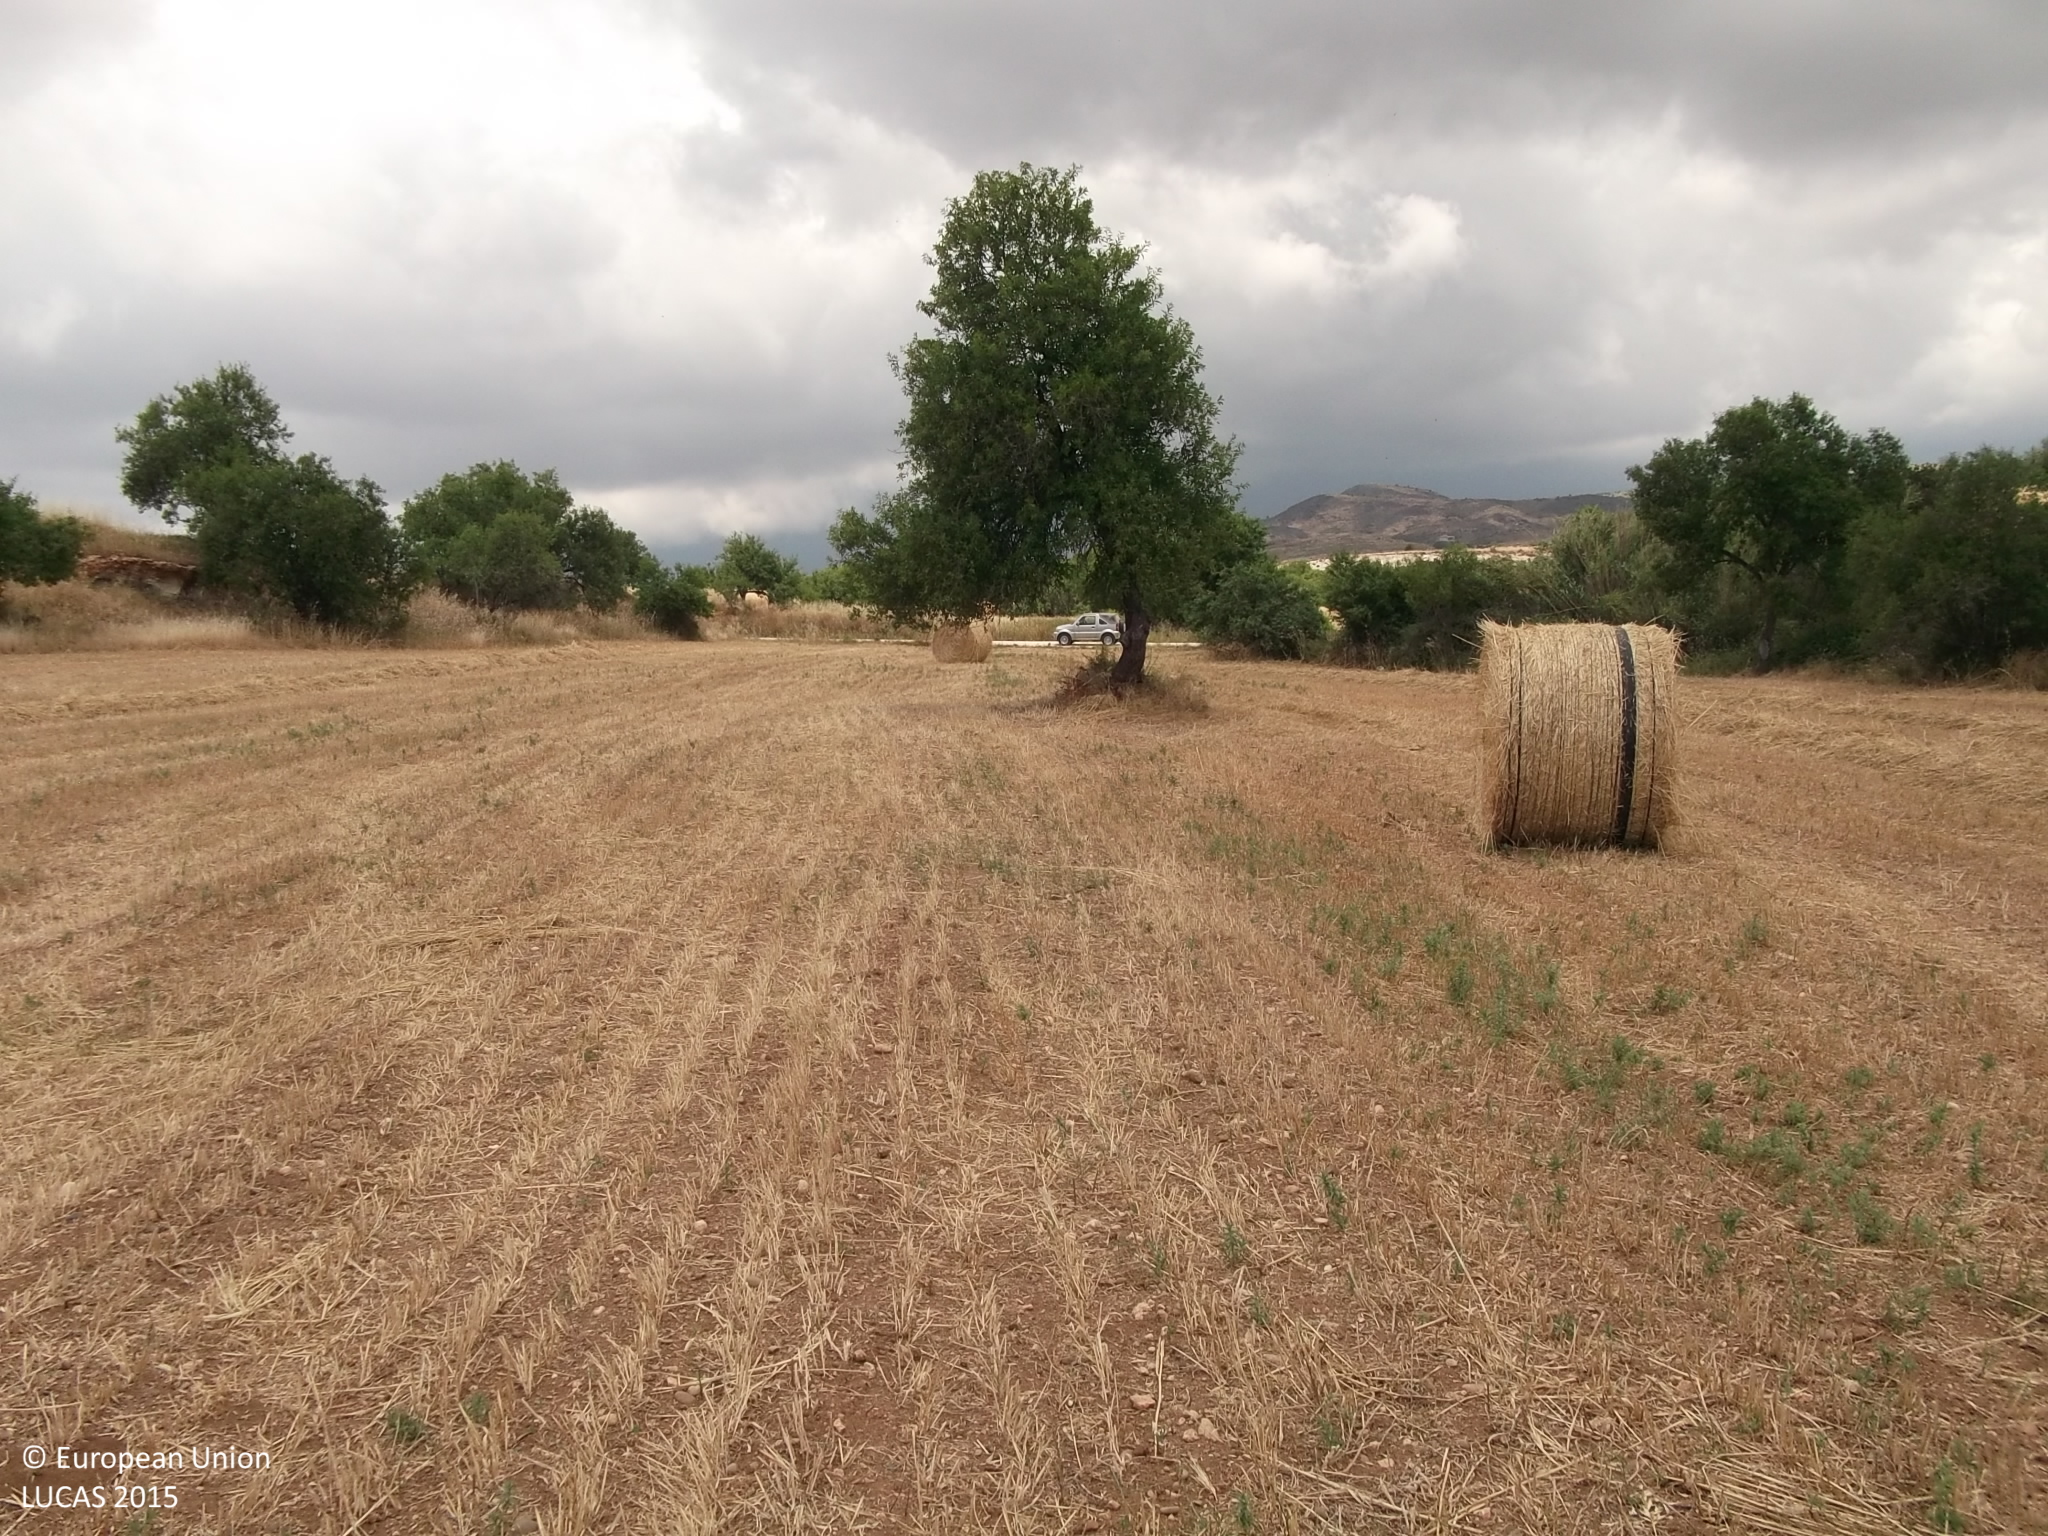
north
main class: Cropland
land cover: Mixed cereals for fodder
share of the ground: < 10 %
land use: Agriculture (excluding fallow land and kitchen gardens)
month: May
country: CY
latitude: 34.7446
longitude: 32.5286
